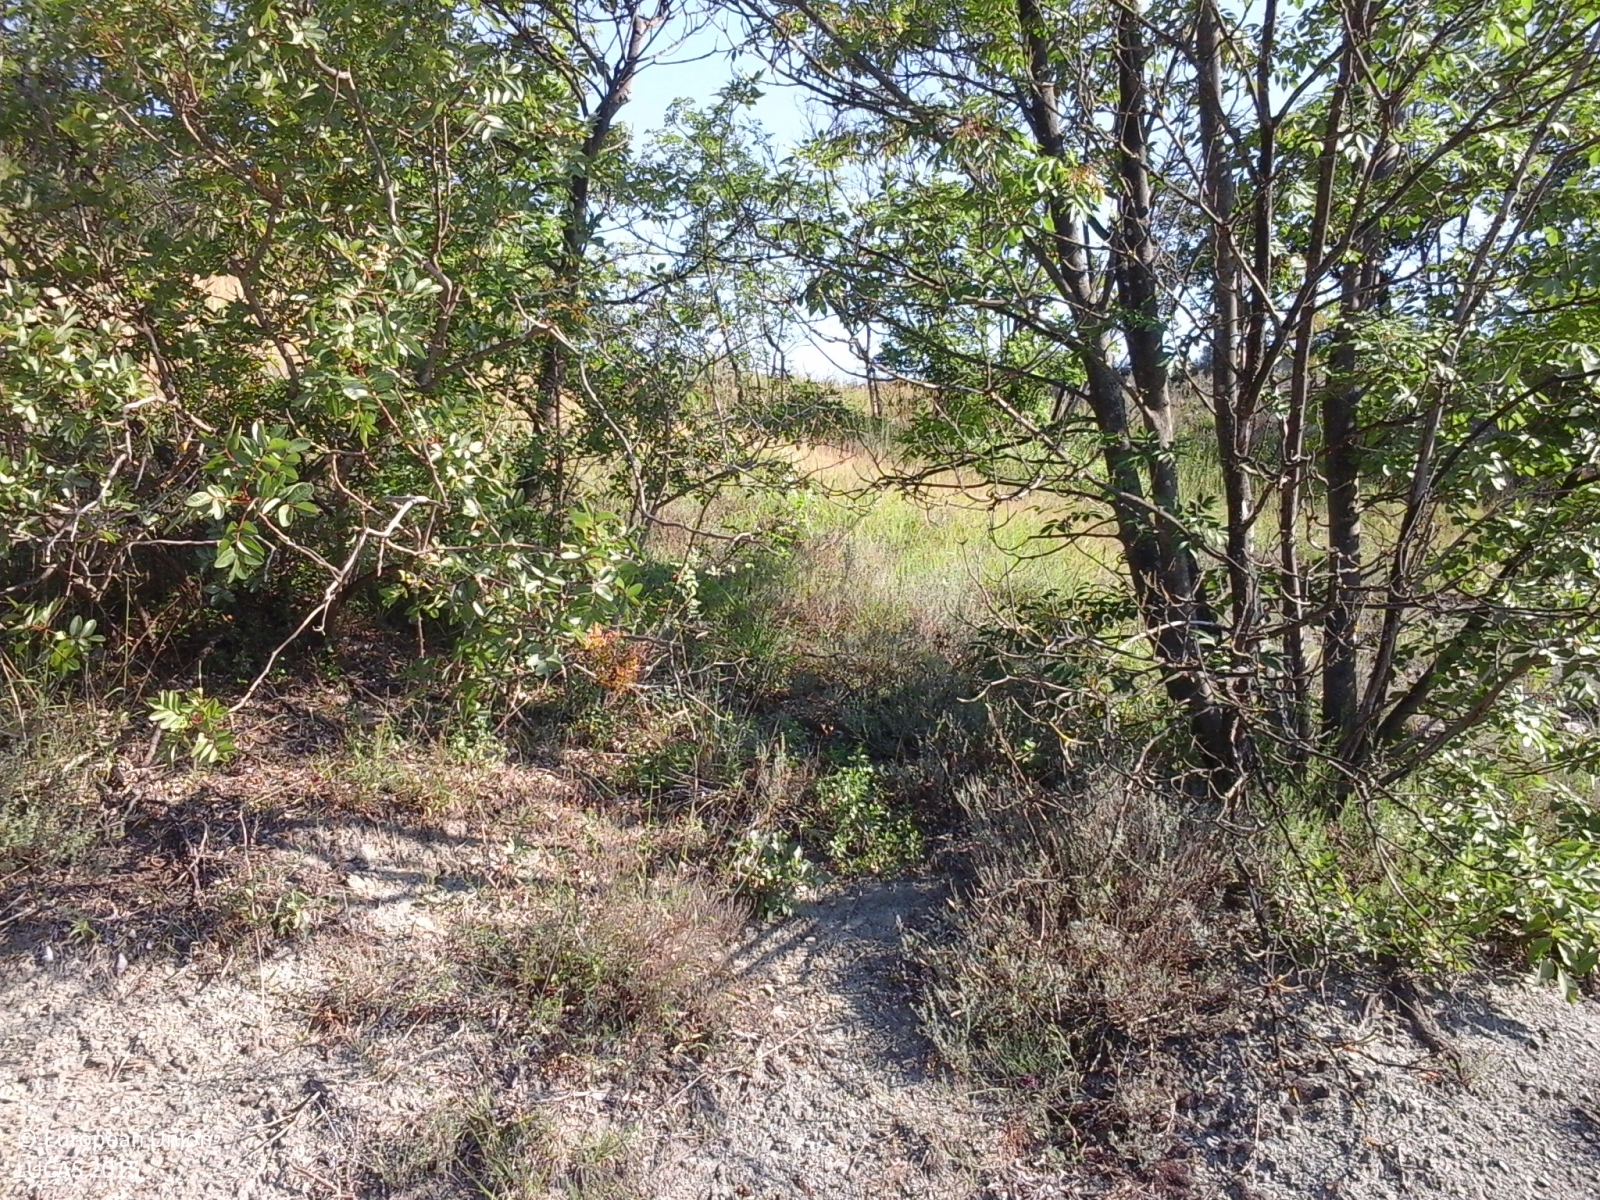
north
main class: Shrubland
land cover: Shrubland with sparse tree cover
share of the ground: > 75 %
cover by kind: herbaceous plants 50 %, consolidated bare surface 25 %, shrubs 20 %, broadleaved forest trees 5 %
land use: Semi-natural and natural areas not in use
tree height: < 5 m
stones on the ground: > 50 %
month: June
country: IT
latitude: 44.5716
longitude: 8.3287
